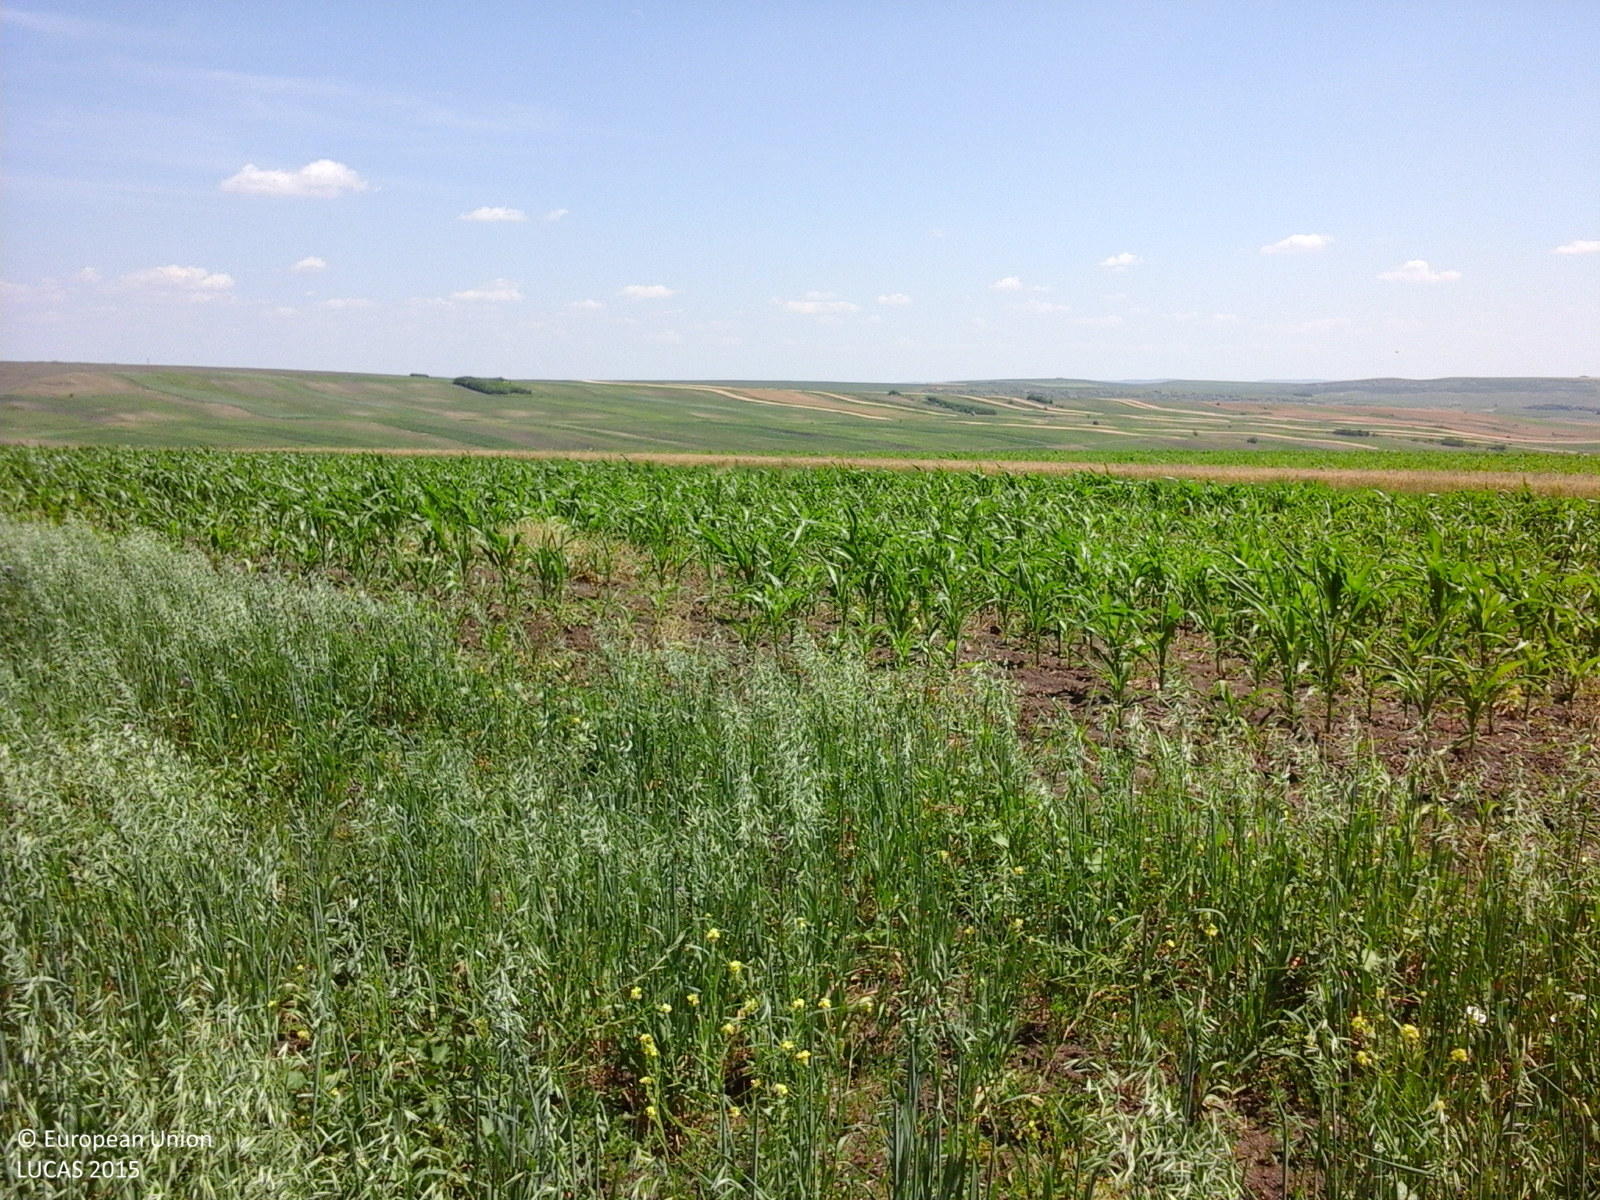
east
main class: Cropland
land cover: Oats
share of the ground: > 75 %
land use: Agriculture (excluding fallow land and kitchen gardens)
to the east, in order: Oats; Maize; Lucerne; Common wheat; Maize; Sunflower; Grass margins; Tracks
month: June
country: RO
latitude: 47.9494
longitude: 27.0452
